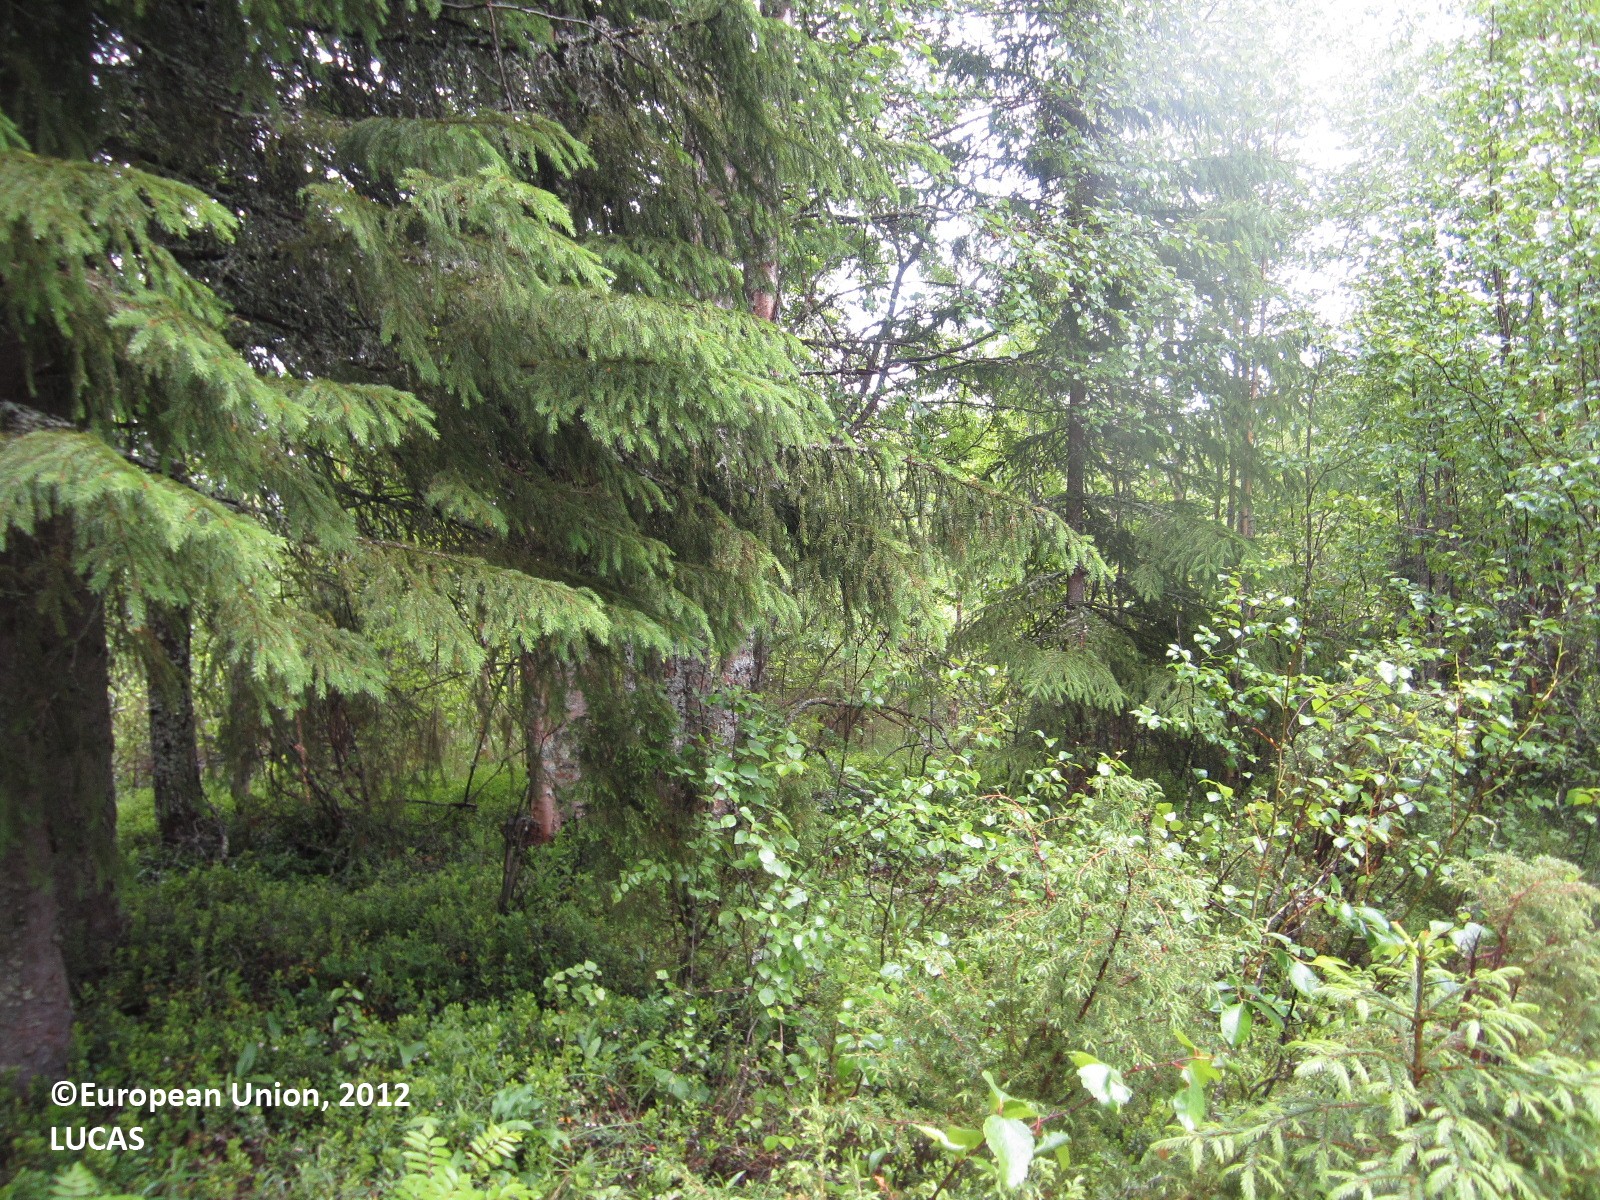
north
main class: Woodland
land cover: Spruce dominated mixed woodland
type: boreal forest
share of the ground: 50 - 75 %
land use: Forestry
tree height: > 5 m
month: June
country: FI
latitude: 64.6120
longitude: 29.9423
